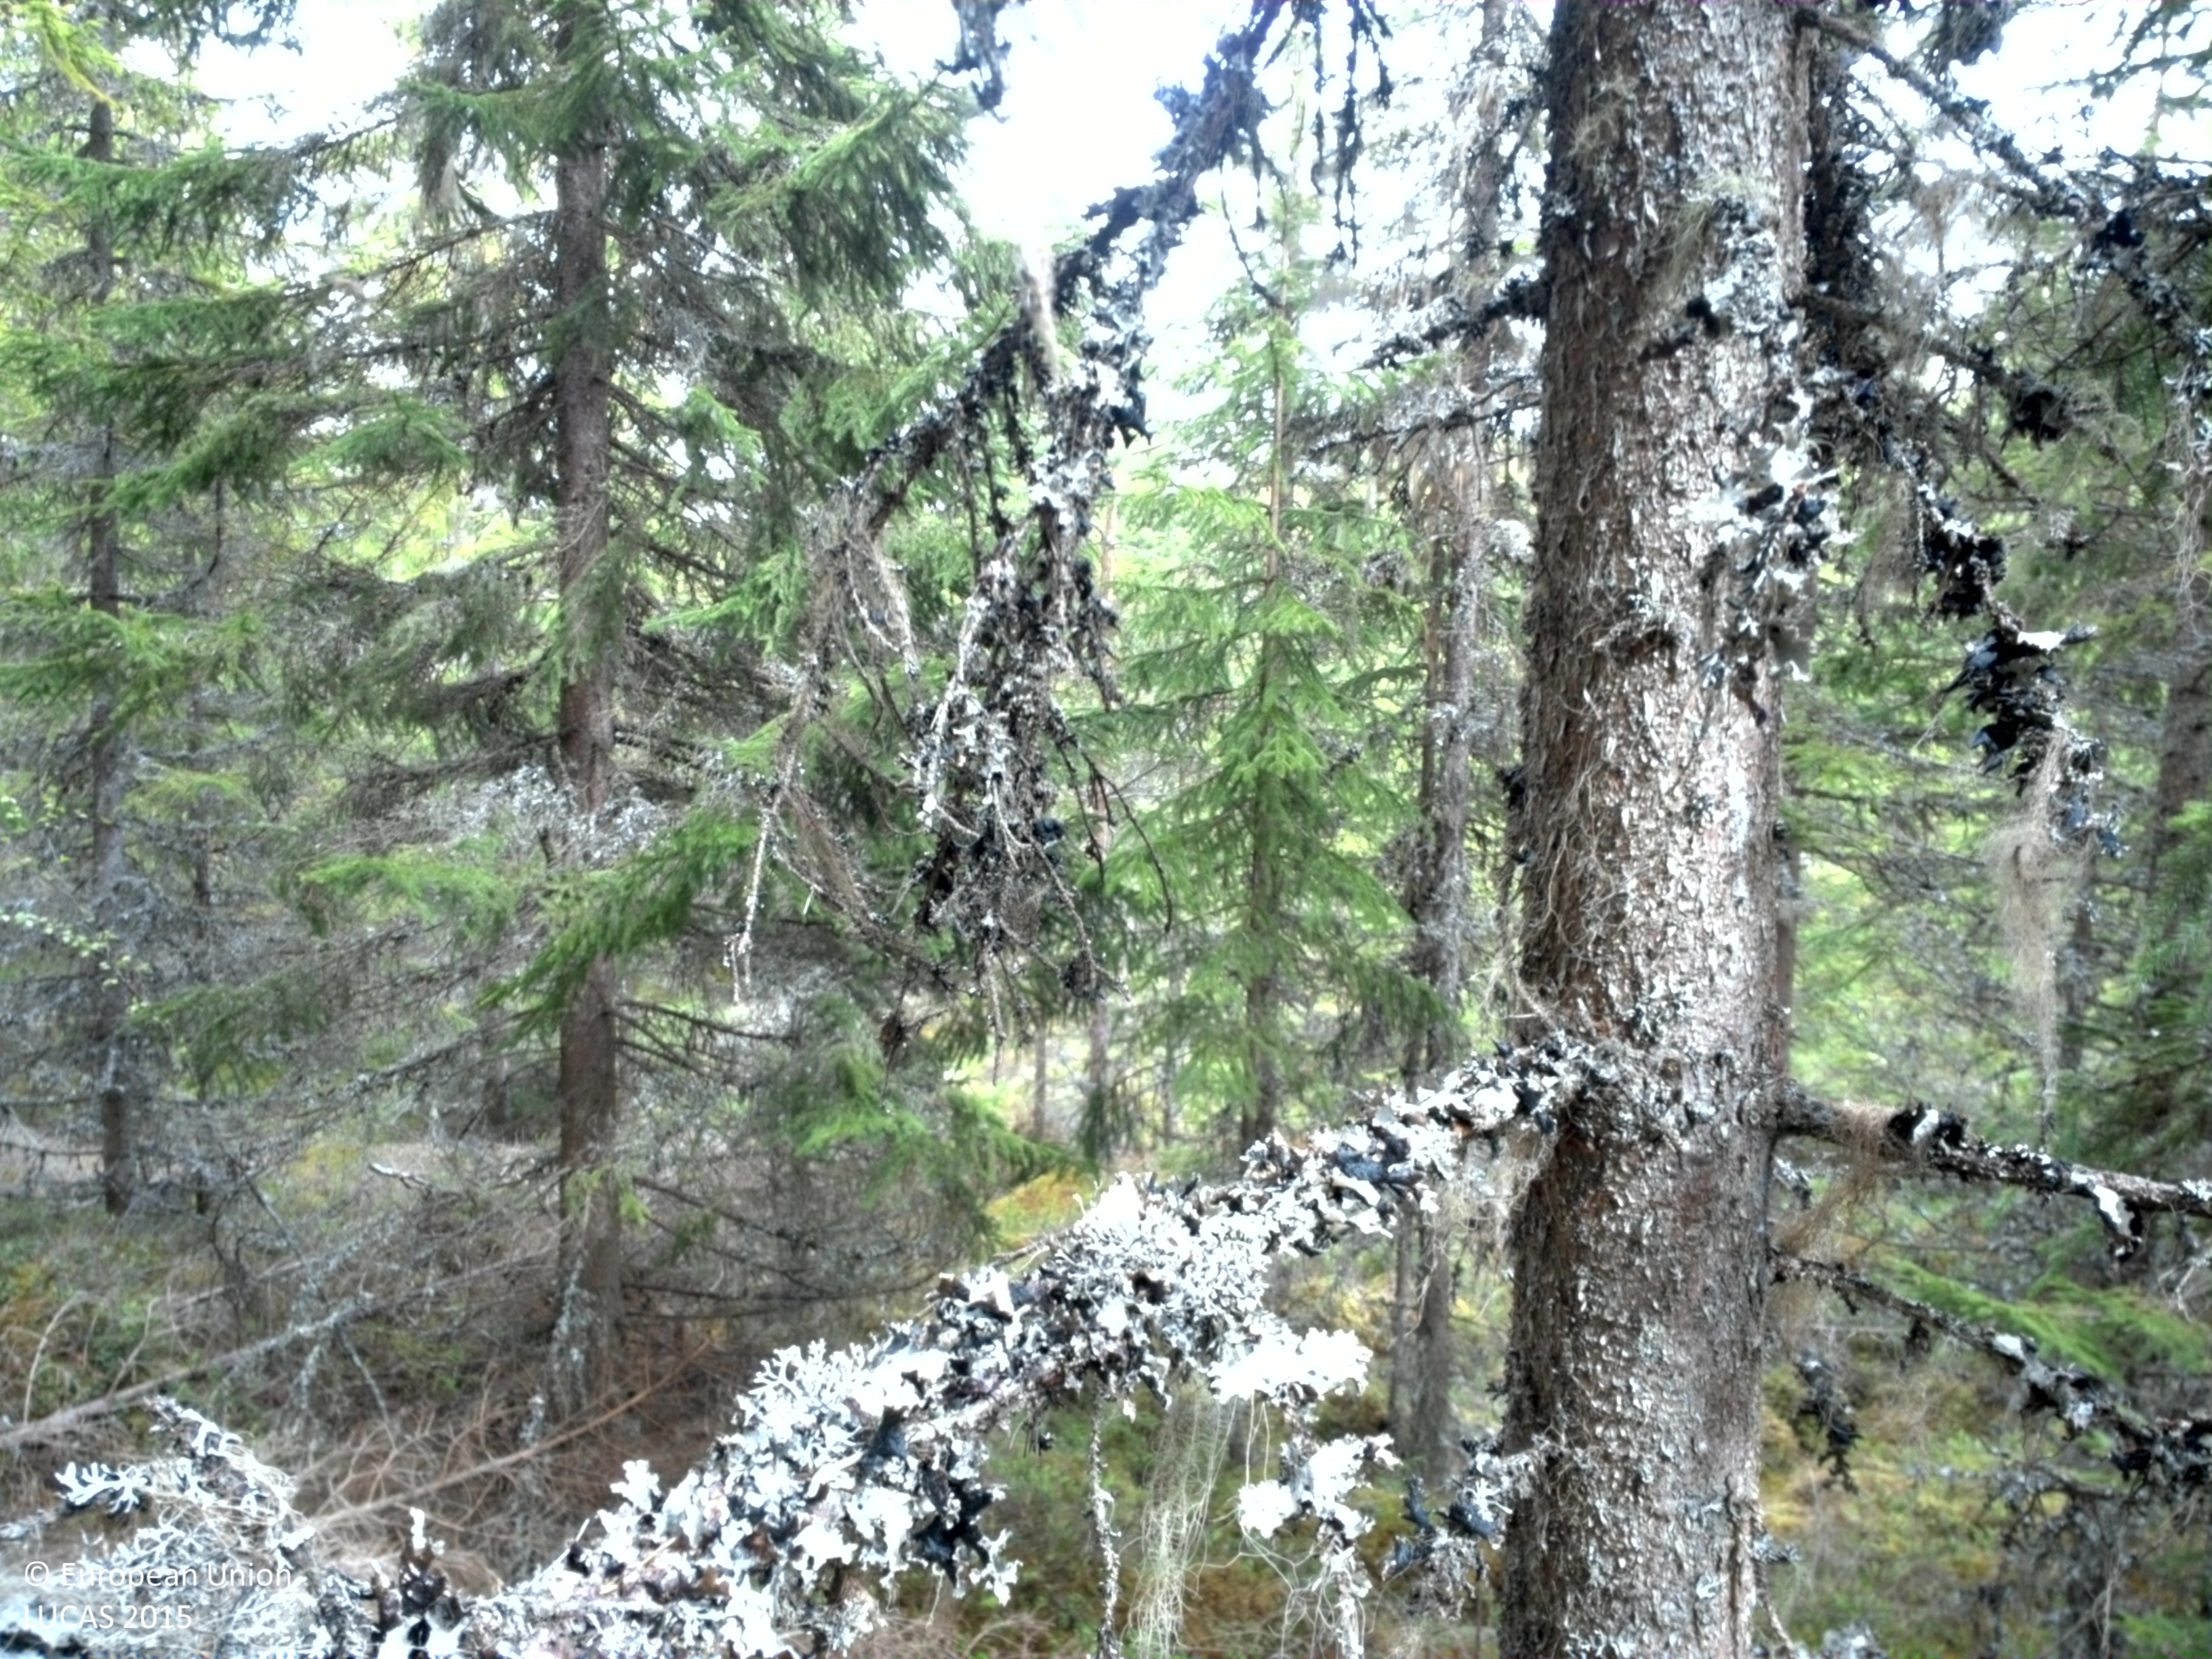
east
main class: Woodland
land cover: Spruce dominated coniferous woodland
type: boreal forest
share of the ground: > 75 %
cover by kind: coniferous forest trees 95 %, shrubs 5 %
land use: Forestry
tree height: > 5 m
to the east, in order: Spruce dominated coniferous woodland; Spruce dominated mixed woodland; Spruce dominated coniferous woodland; Spruce dominated mixed woodland; Spruce dominated coniferous woodland
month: May
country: SE
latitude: 60.1260
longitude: 13.2128
